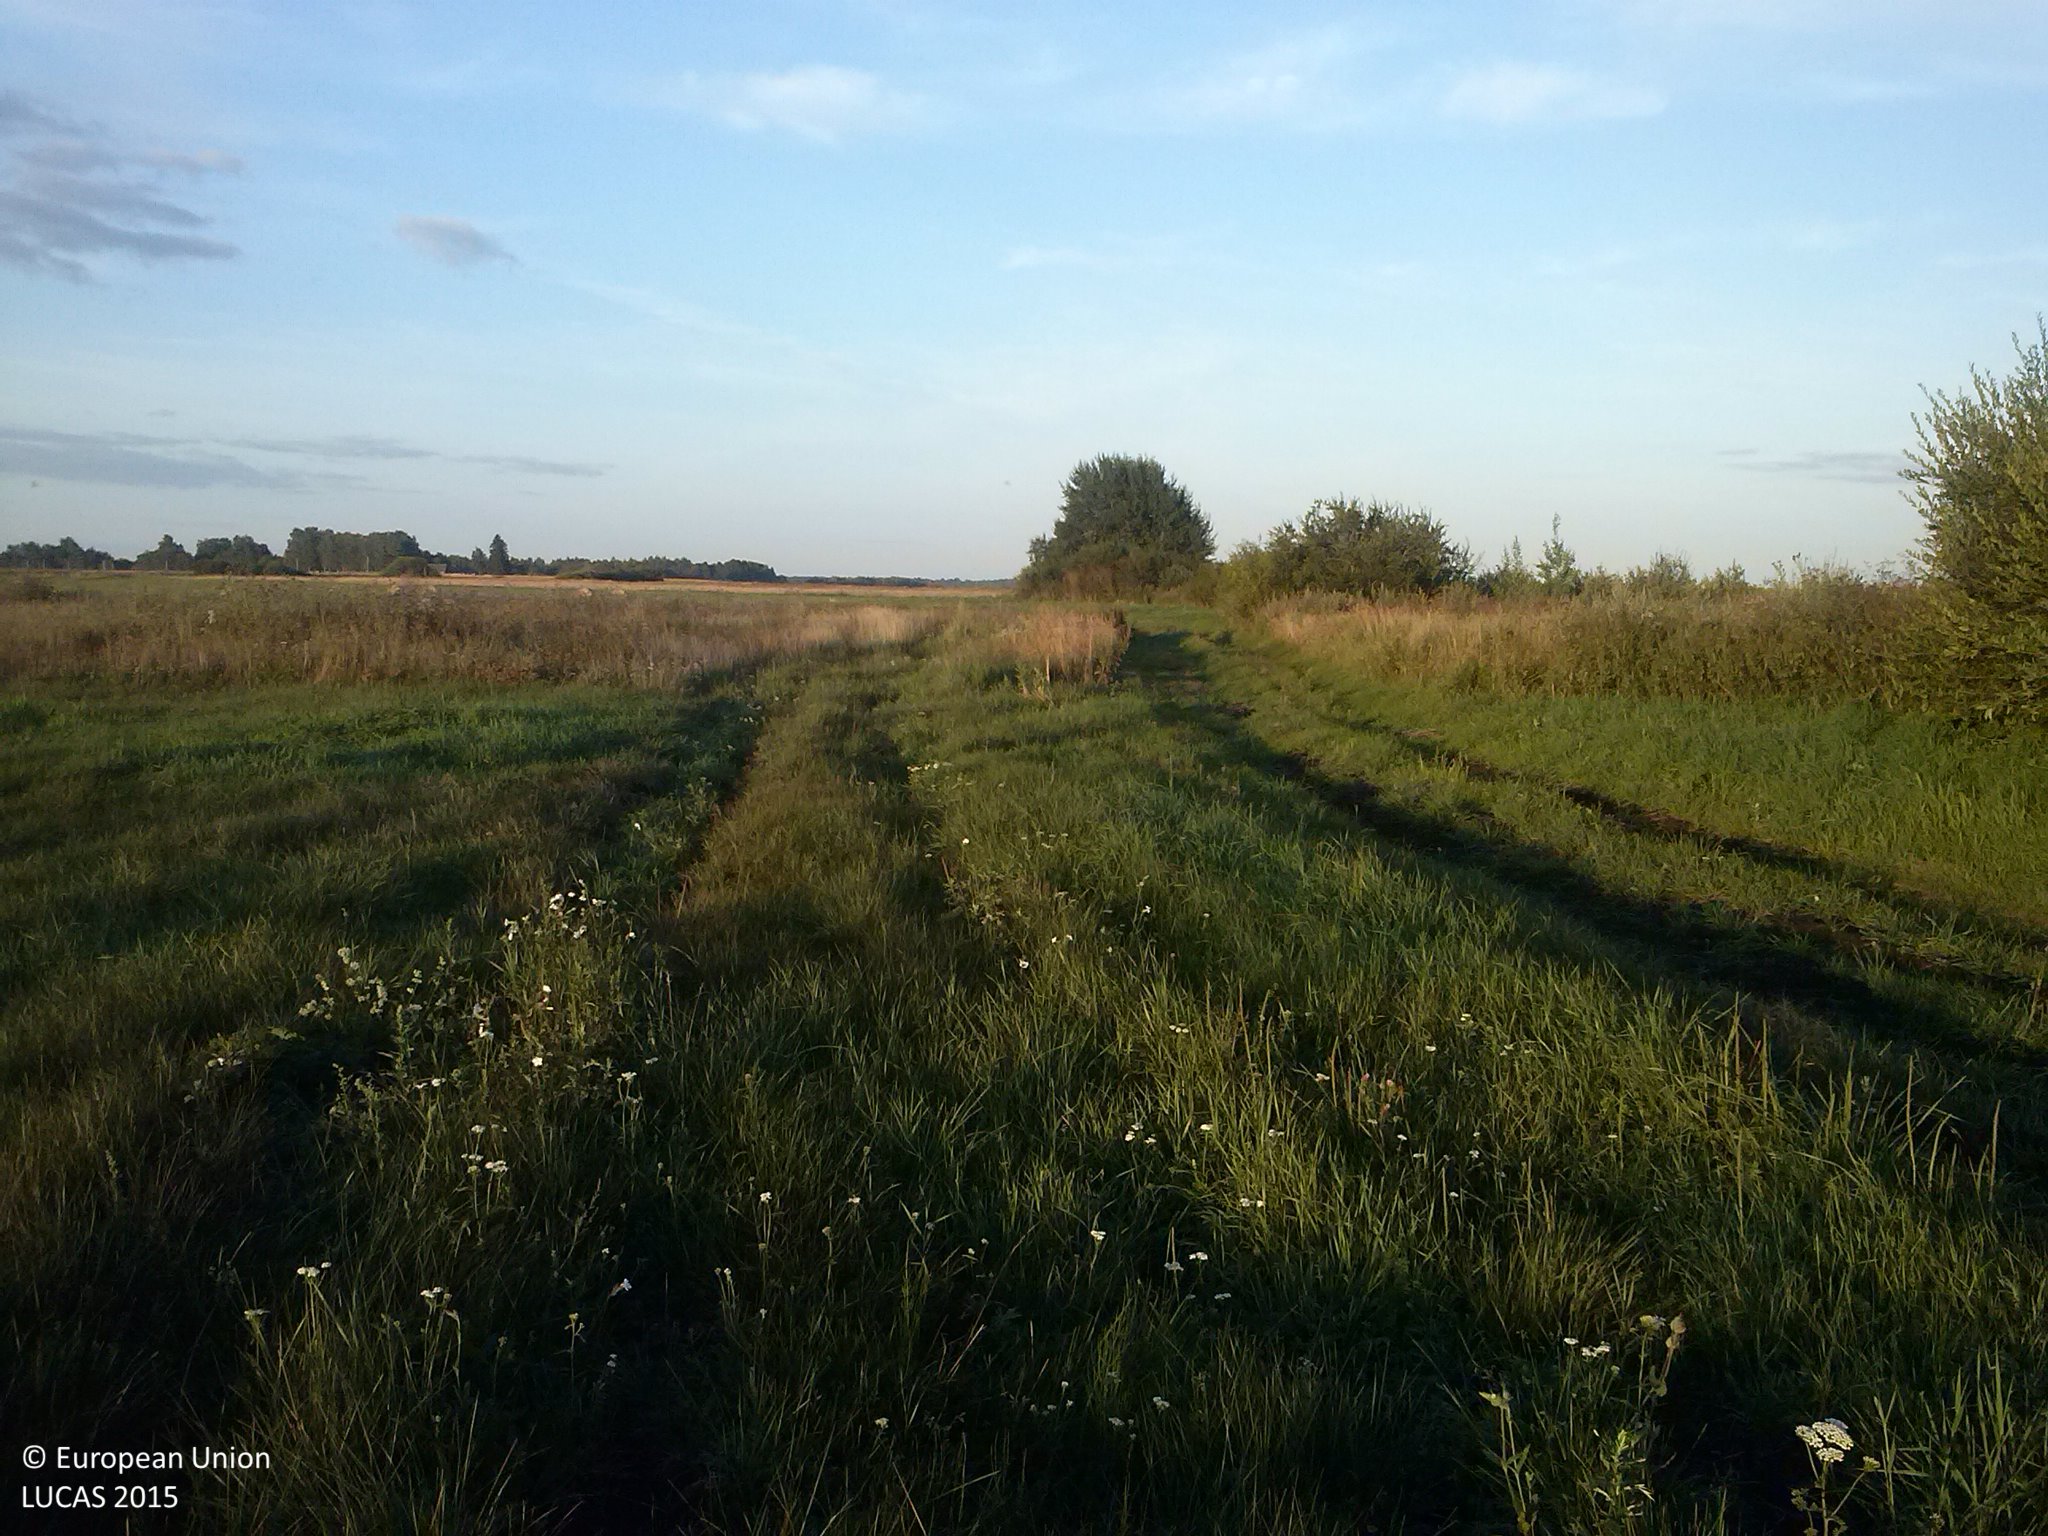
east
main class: Grassland
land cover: Grassland without tree/shrub cover
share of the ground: > 75 %
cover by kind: herbaceous plants 100 %
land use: Agriculture (excluding fallow land and kitchen gardens)
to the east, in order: Grassland without tree/shrub cover; Grassland with sparse tree/shrub cover; Tracks; Grassland without tree/shrub cover
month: July
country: LV
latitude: 56.6689
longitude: 26.9520
